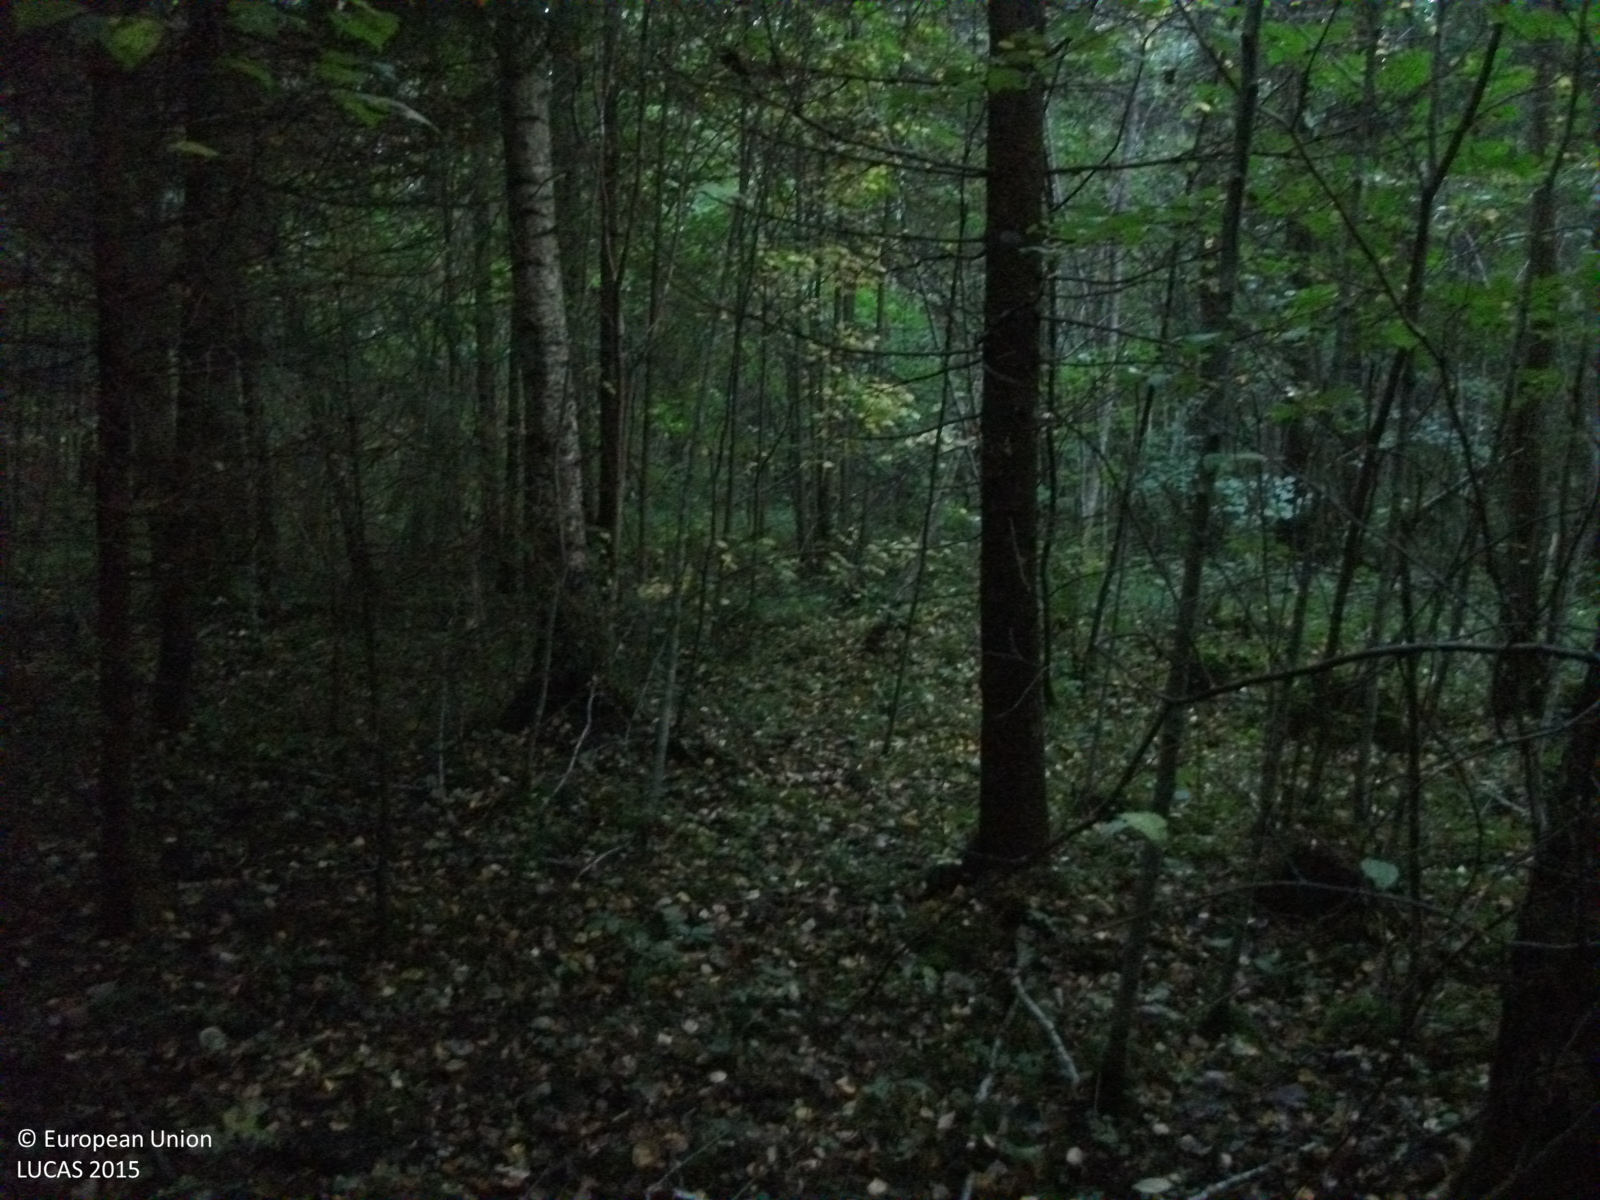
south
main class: Woodland
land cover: Spruce dominated mixed woodland
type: hemiboreal forest and nemoral coniferous forest and mixed broadleaved-coniferous forest
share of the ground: > 75 %
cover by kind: coniferous forest trees 55 %, broadleaved forest trees 35 %, herbaceous plants 5 %, unconsolidated bare surface 5 %
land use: Forestry
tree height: > 5 m
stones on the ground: < 10 %
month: September
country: LV
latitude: 57.7848
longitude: 24.7438
